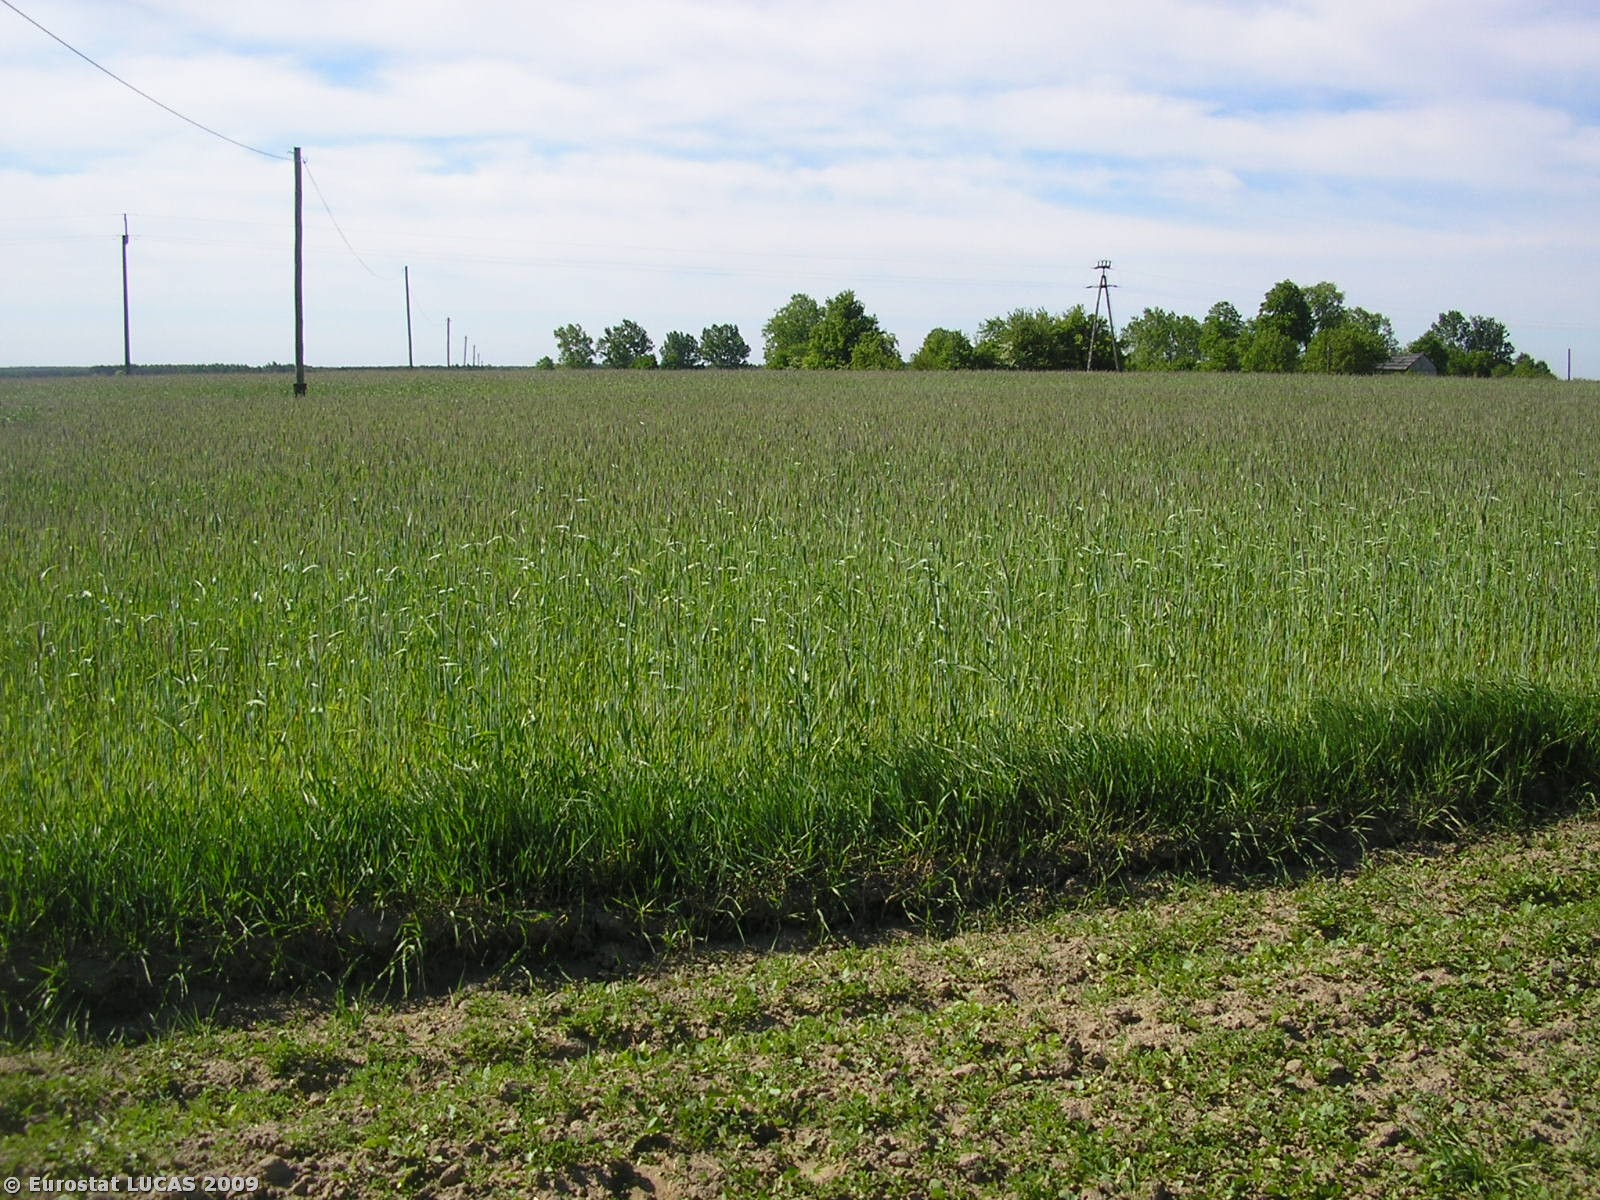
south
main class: Cropland
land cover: Other leguminous and mixtures for fodder
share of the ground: 10 - 25 %
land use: Agriculture (excluding fallow land and kitchen gardens)
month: May
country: PL
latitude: 51.6954
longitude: 20.0595
